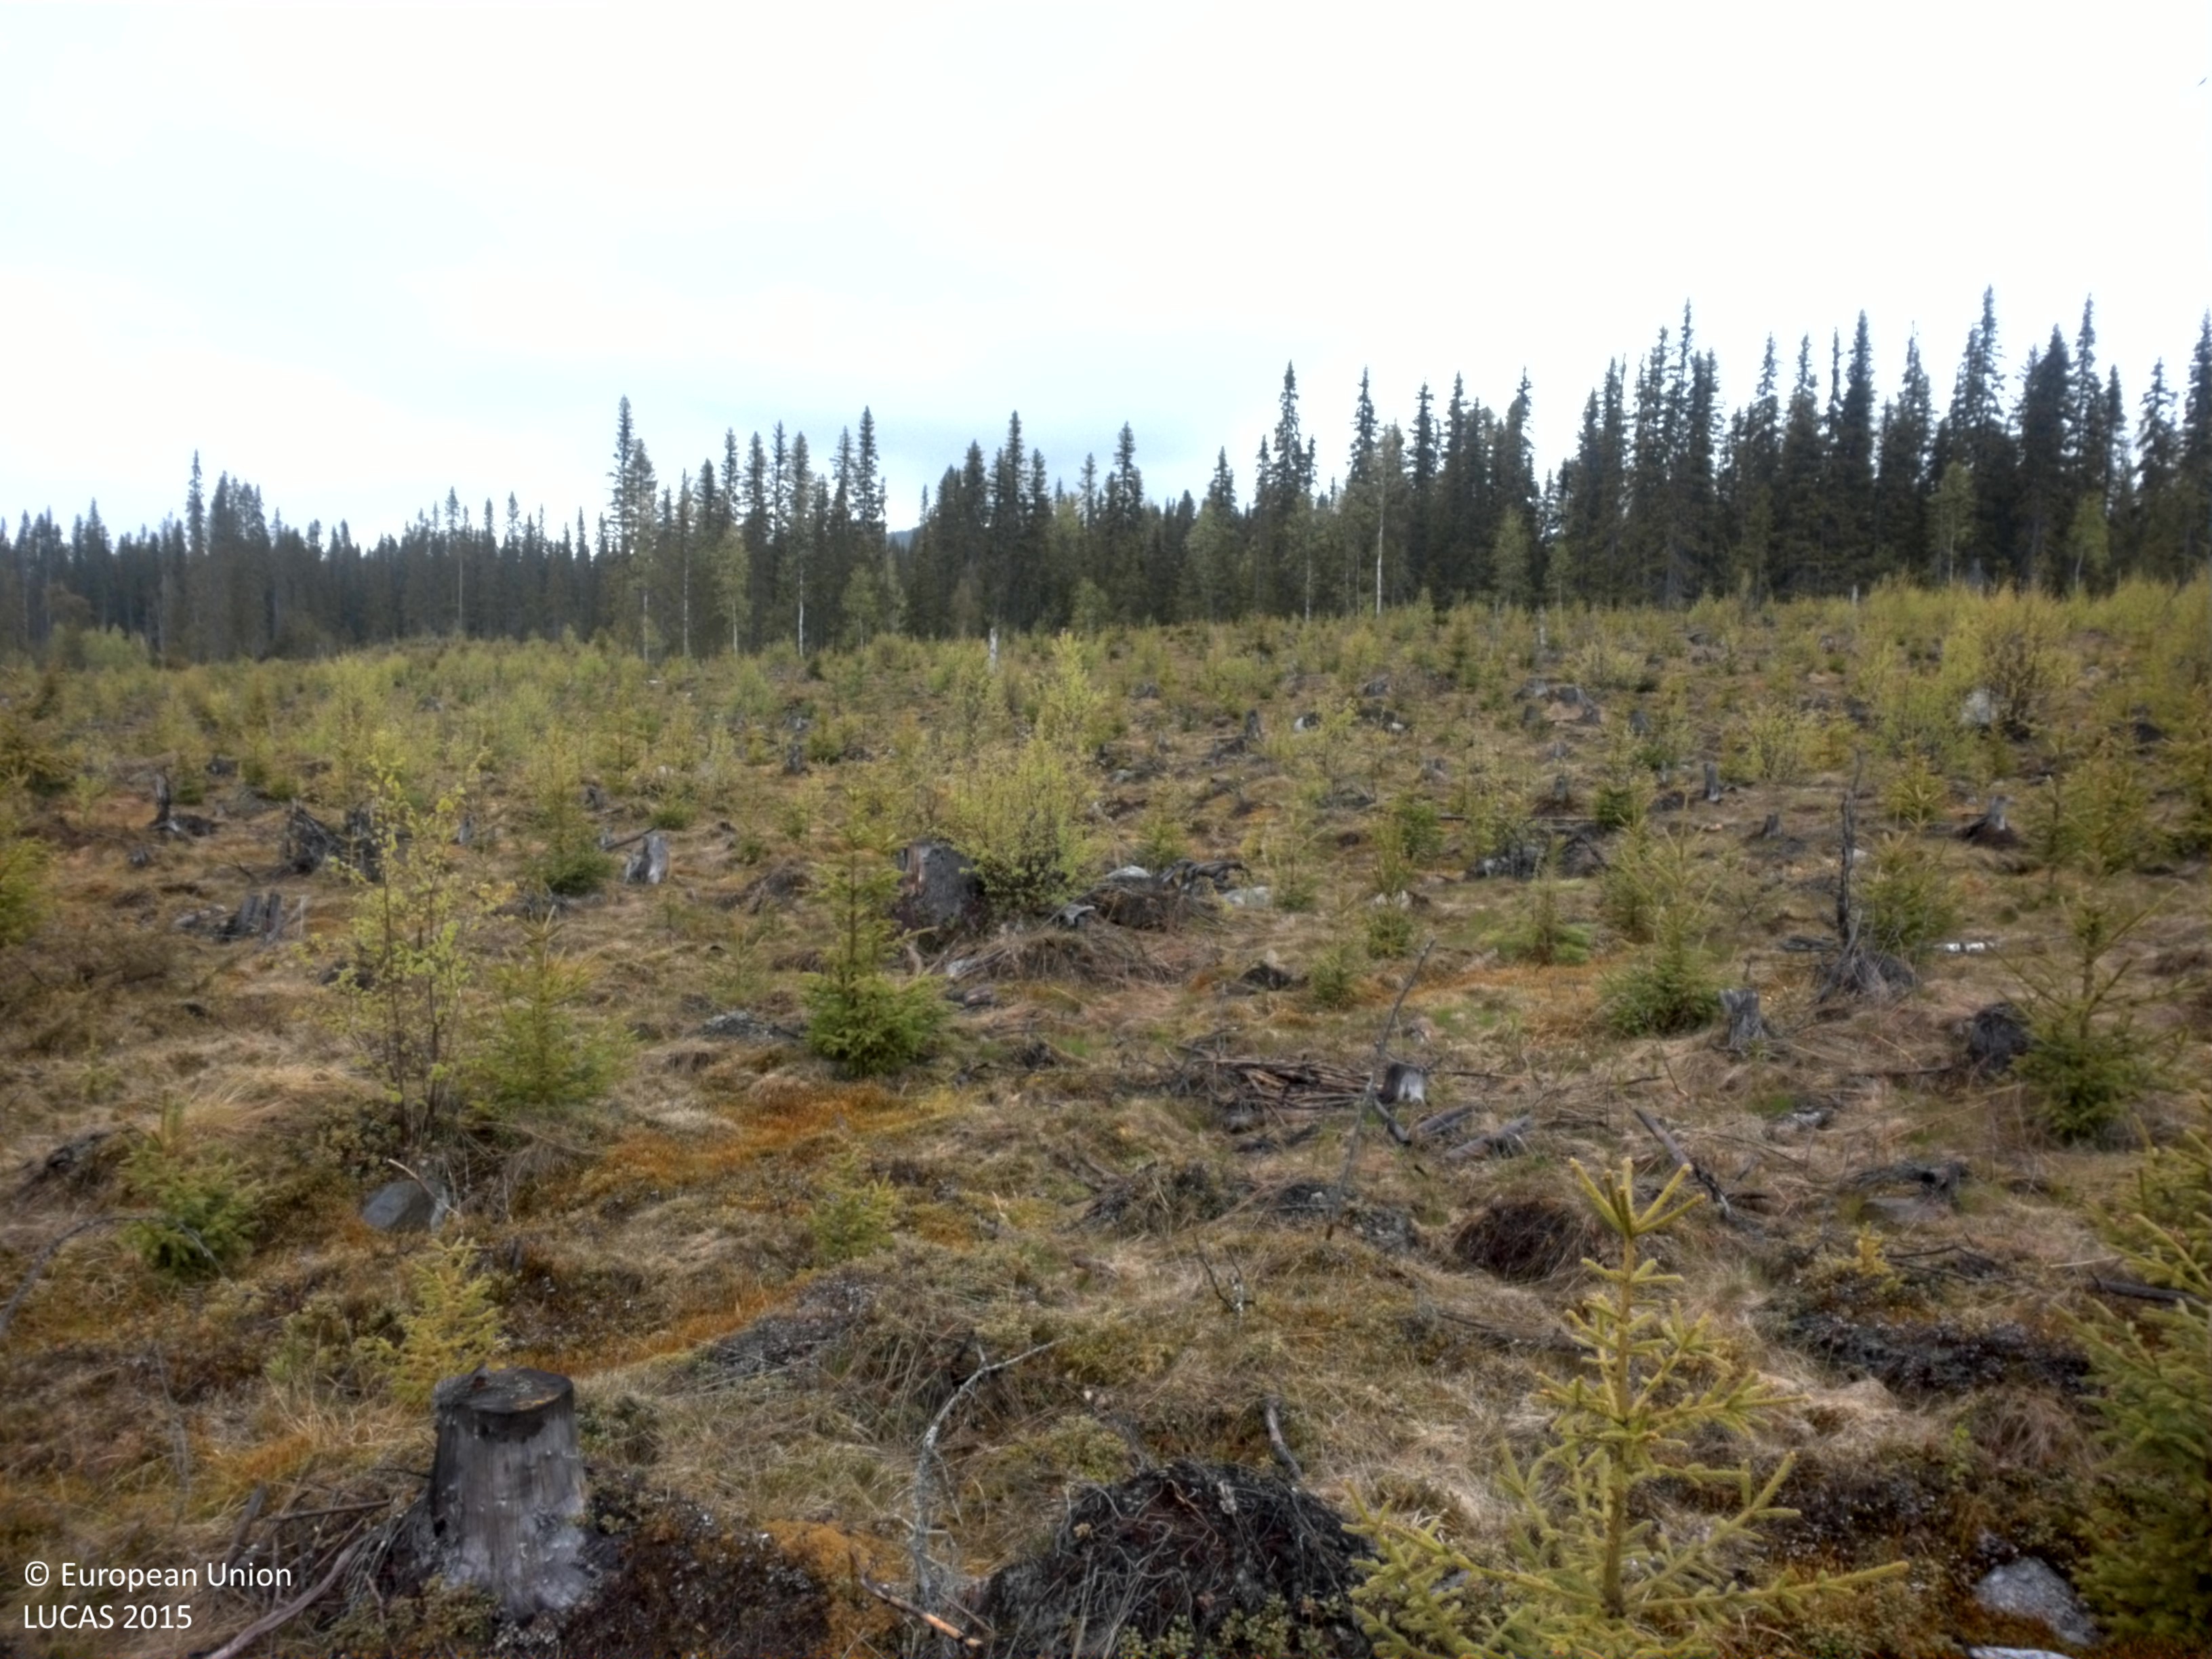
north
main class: Woodland
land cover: Spruce dominated coniferous woodland
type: boreal forest
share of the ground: 10 - 25 %
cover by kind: herbaceous plants 40 %, lichens and mosses 30 %, coniferous forest trees 15 %, broadleaved forest trees 5 %, shrubs 5 %, unconsolidated bare surface 5 %
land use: Forestry
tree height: < 5 m
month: June
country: SE
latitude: 64.4043
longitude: 17.4571
